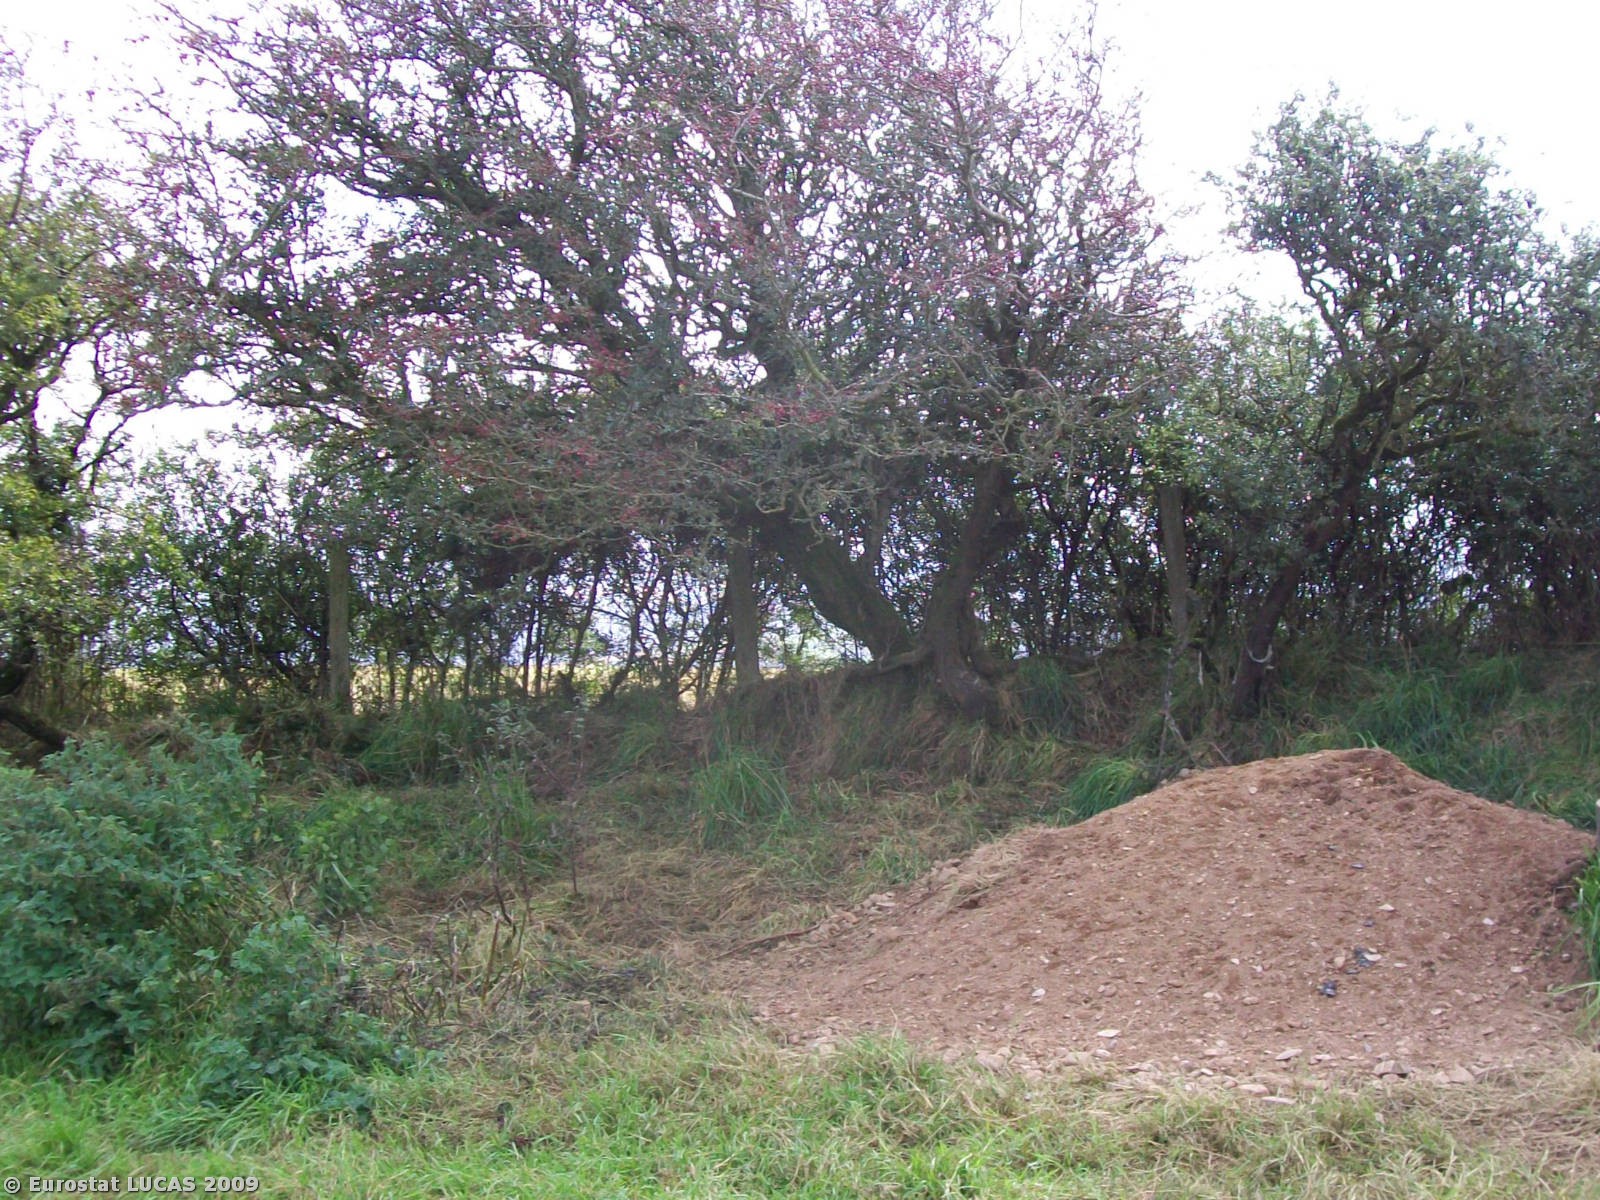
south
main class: Grassland
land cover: Grassland without tree/shrub cover
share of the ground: > 75 %
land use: Agriculture (excluding fallow land and kitchen gardens)
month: September
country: GB
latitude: 52.0330
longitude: -4.7609
